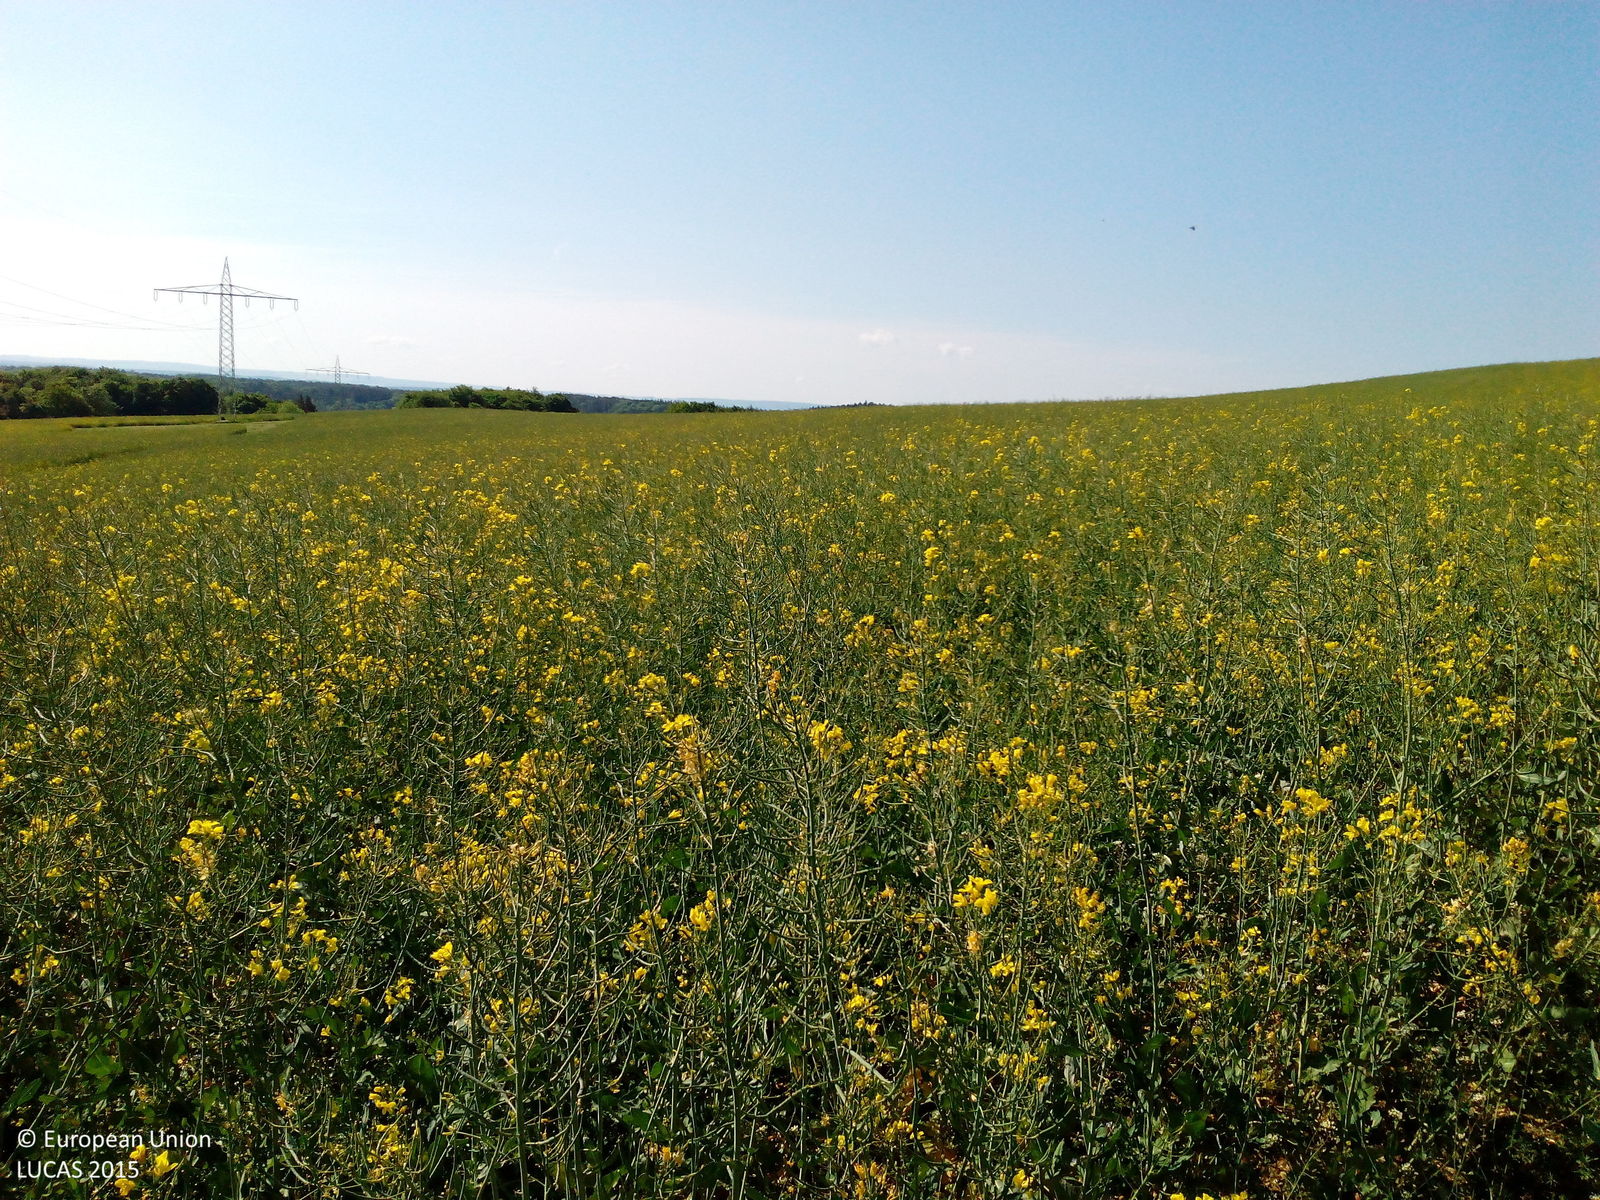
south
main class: Cropland
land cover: Rape and turnip rape
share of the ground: > 75 %
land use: Agriculture (excluding fallow land and kitchen gardens)
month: May
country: DE
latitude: 50.8395
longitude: 11.5191
